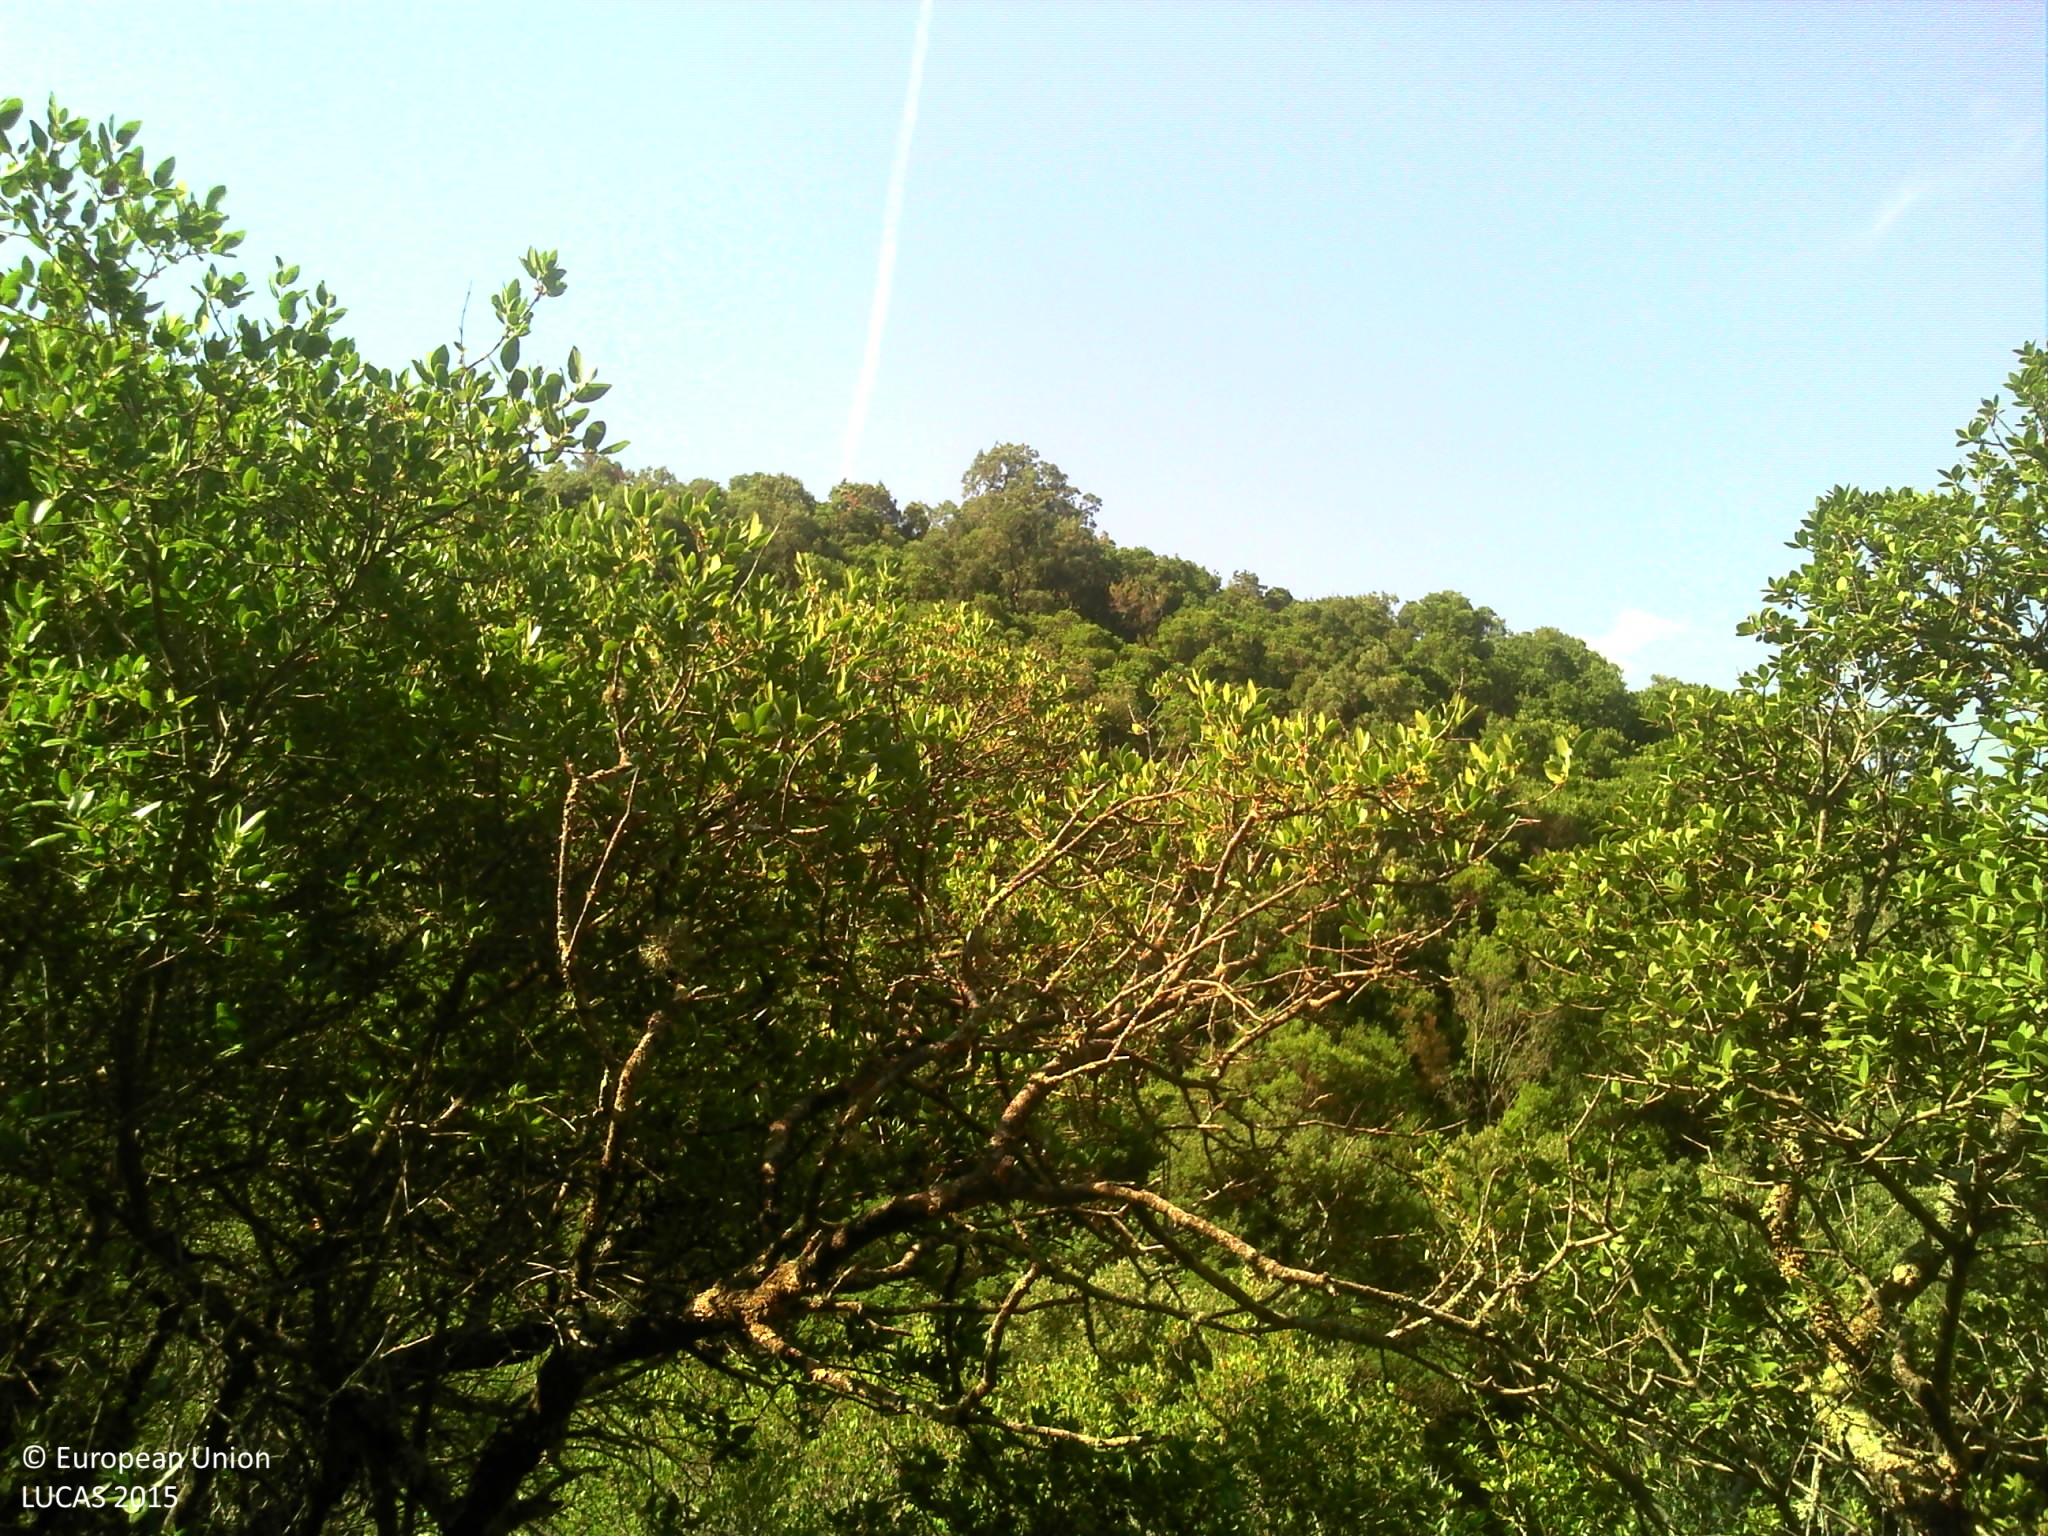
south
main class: Woodland
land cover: Broadleaved woodland
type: thermophilous deciduous forest
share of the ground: > 75 %
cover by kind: broadleaved forest trees 80 %, unconsolidated bare surface 20 %
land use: Semi-natural and natural areas not in use
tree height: > 5 m
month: July
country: FR
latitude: 43.2570
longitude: 6.3508
